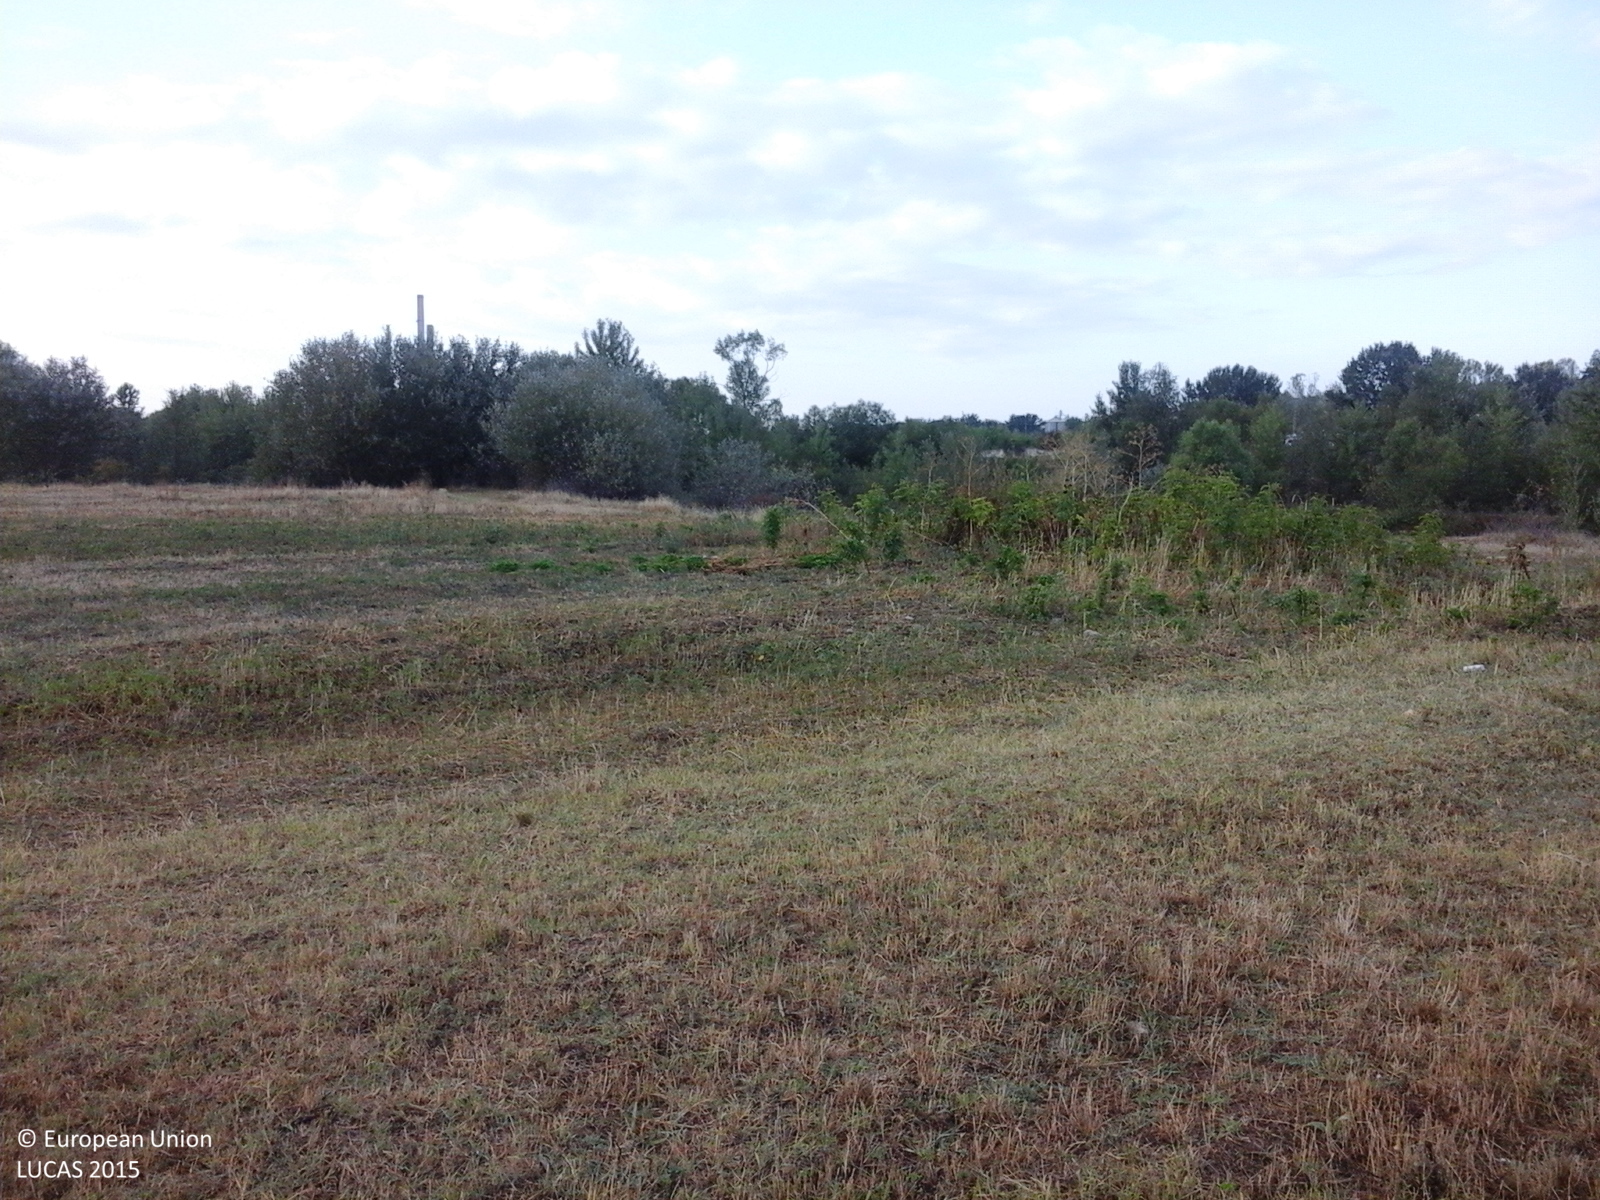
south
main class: Grassland
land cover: Grassland without tree/shrub cover
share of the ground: > 75 %
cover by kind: herbaceous plants 100 %
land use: Agriculture (excluding fallow land and kitchen gardens)
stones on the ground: < 10 %
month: August
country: RO
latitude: 44.7005
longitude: 22.6752
